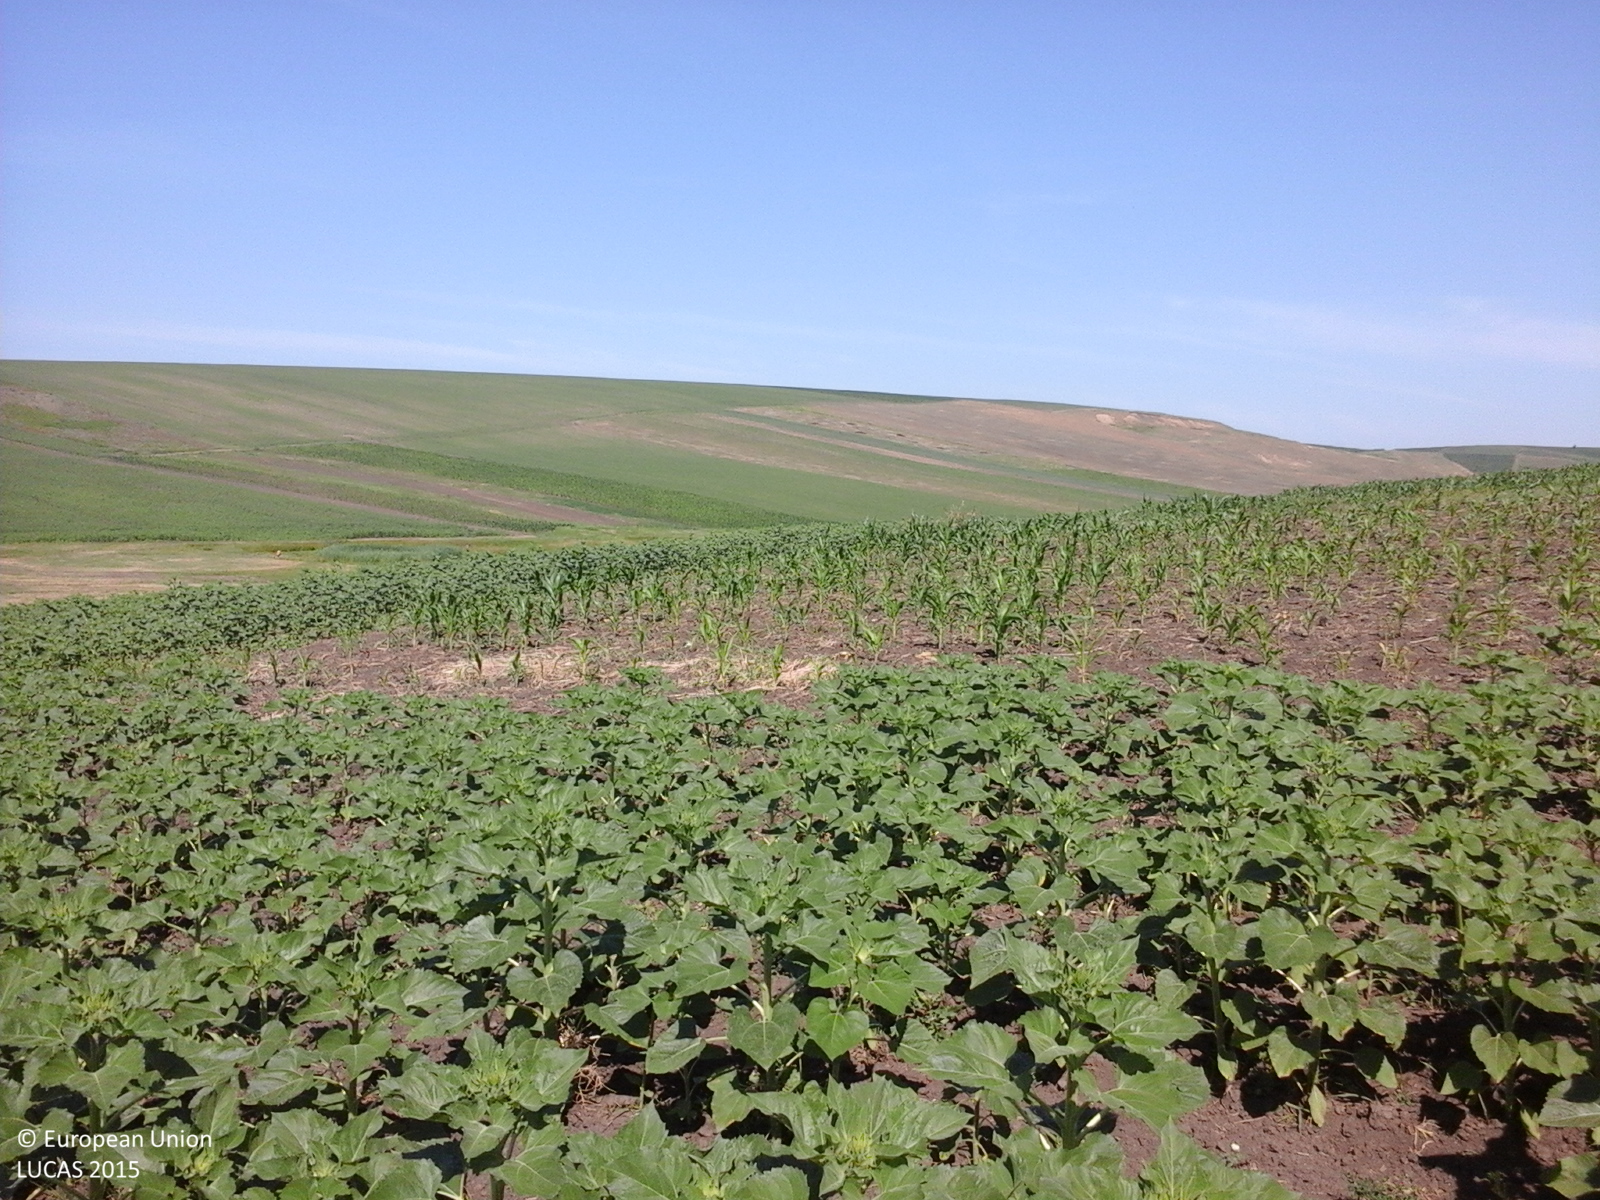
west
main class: Cropland
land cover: Sunflower
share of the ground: 50 - 75 %
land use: Agriculture (excluding fallow land and kitchen gardens)
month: June
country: RO
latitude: 47.3713
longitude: 27.0958
